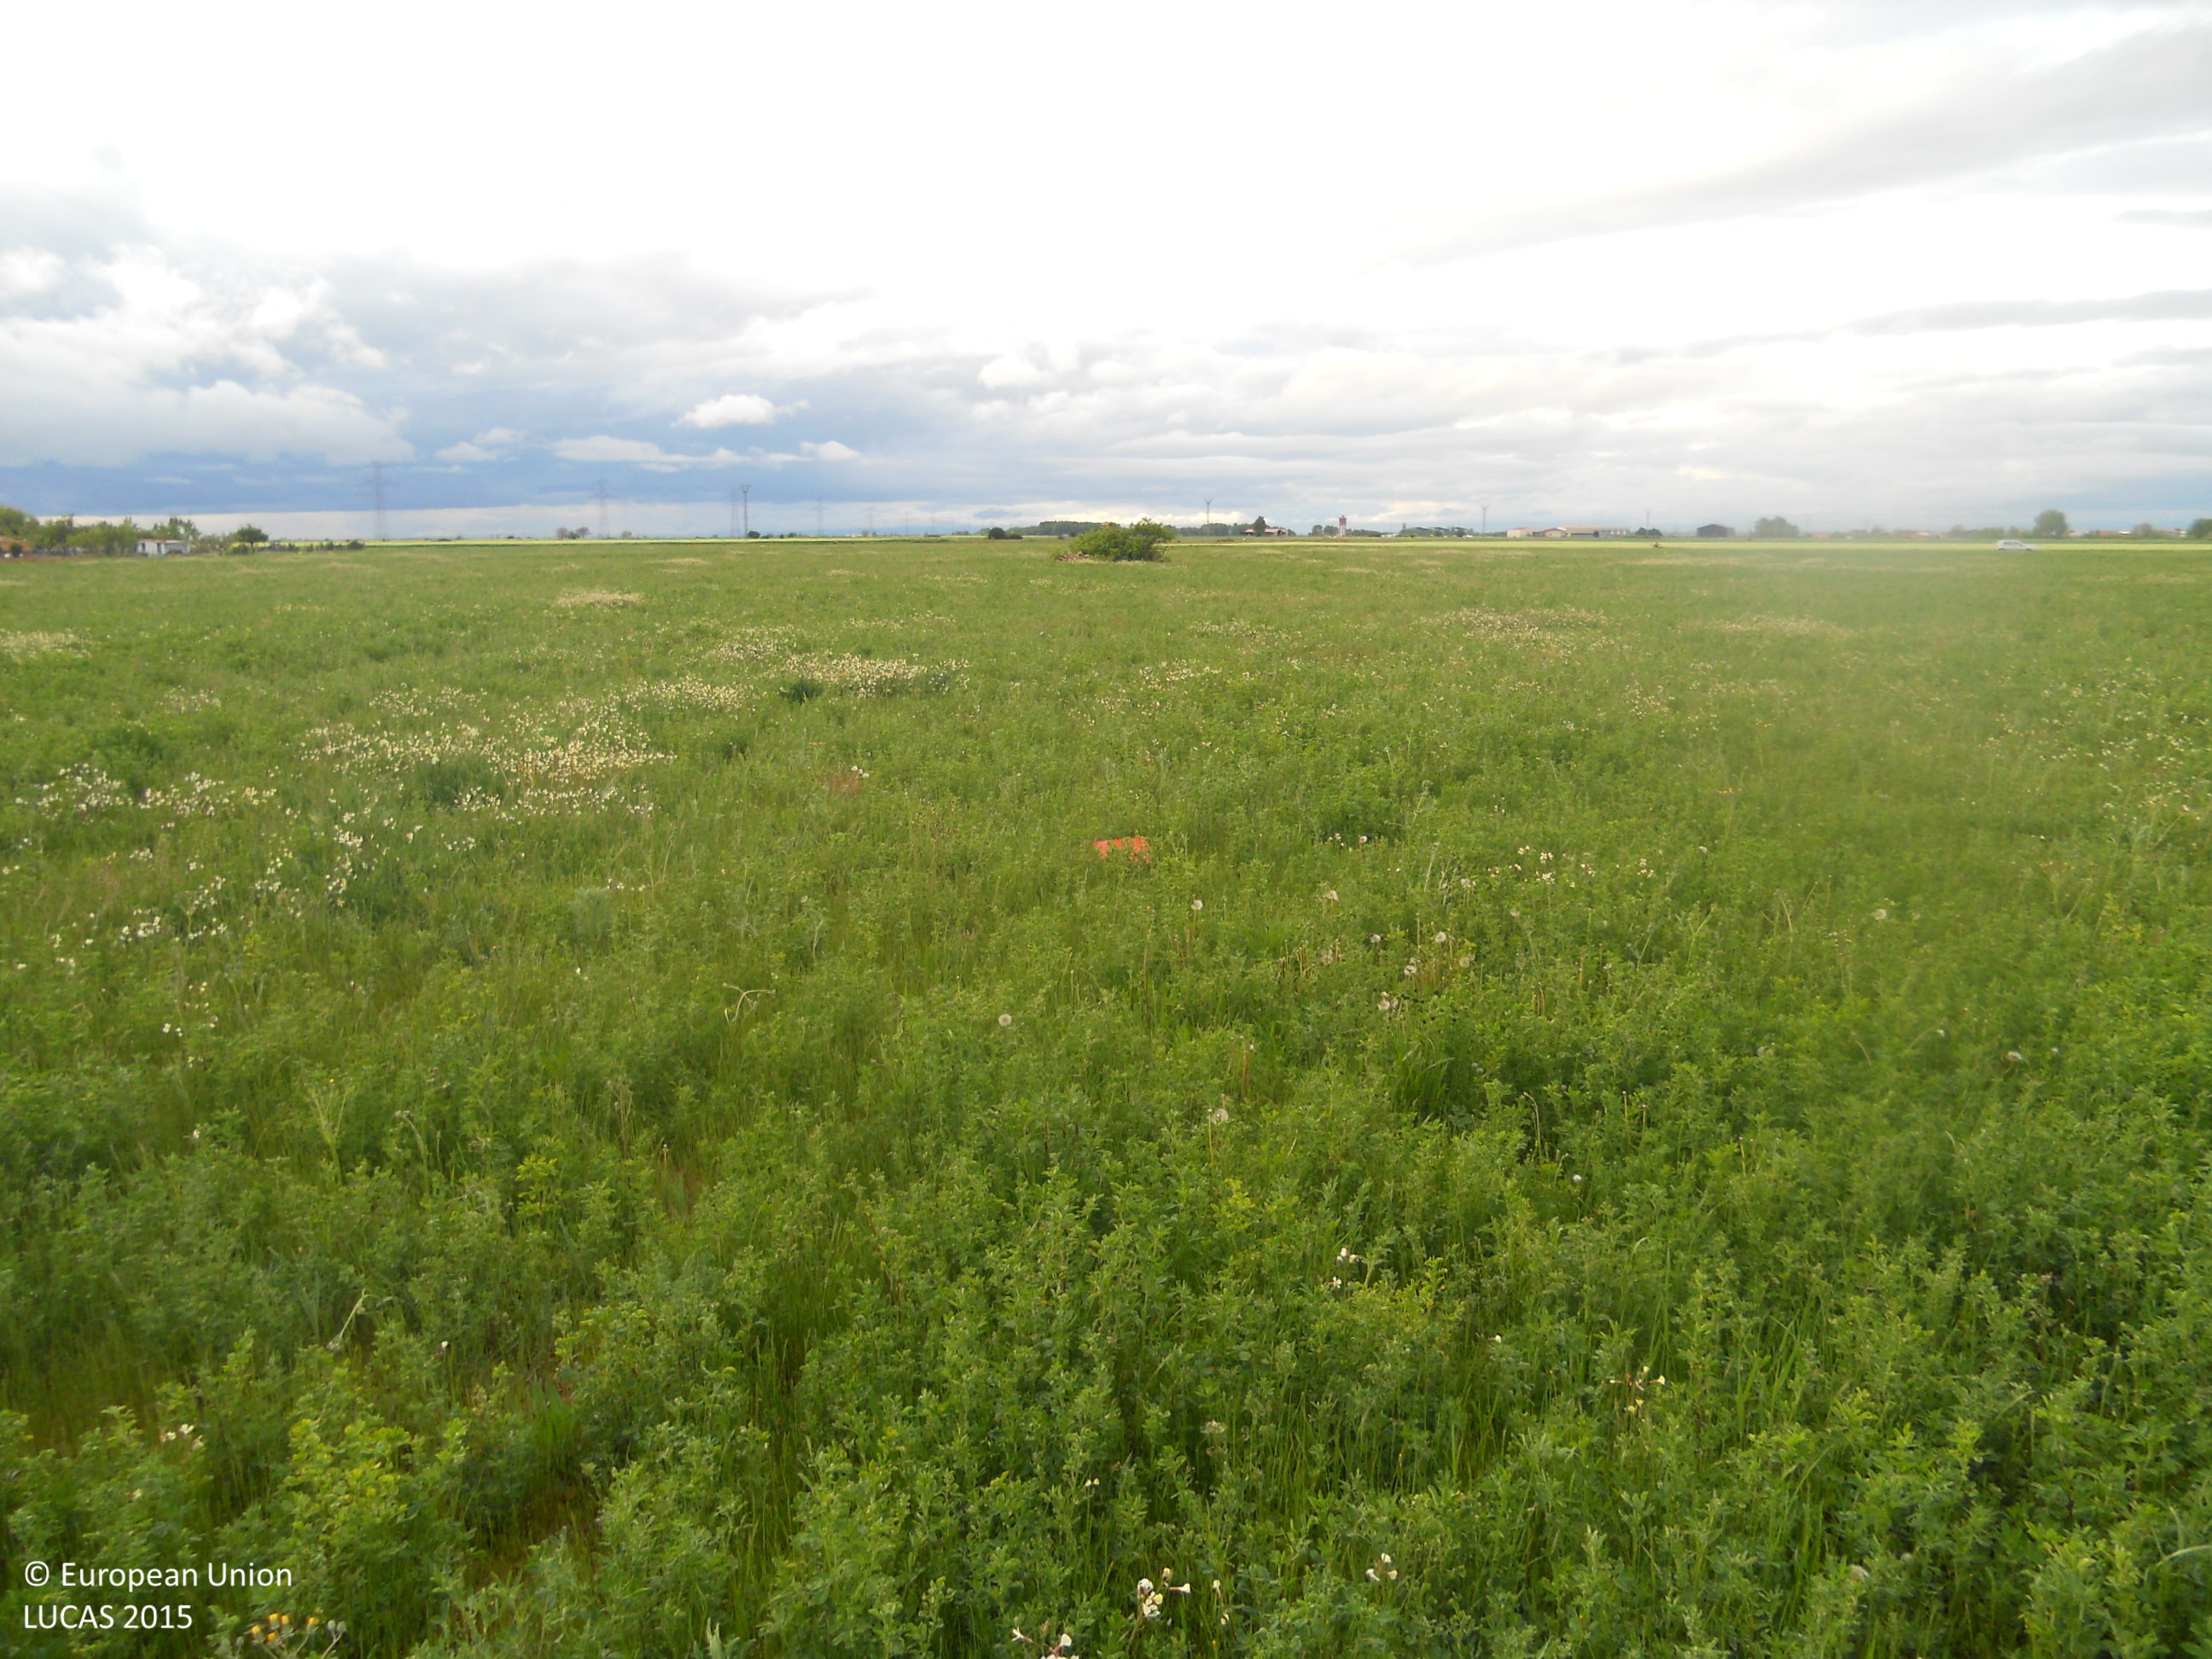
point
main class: Cropland
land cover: Lucerne
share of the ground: > 75 %
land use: Agriculture (excluding fallow land and kitchen gardens)
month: May
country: ES
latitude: 42.3109
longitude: -5.2893
